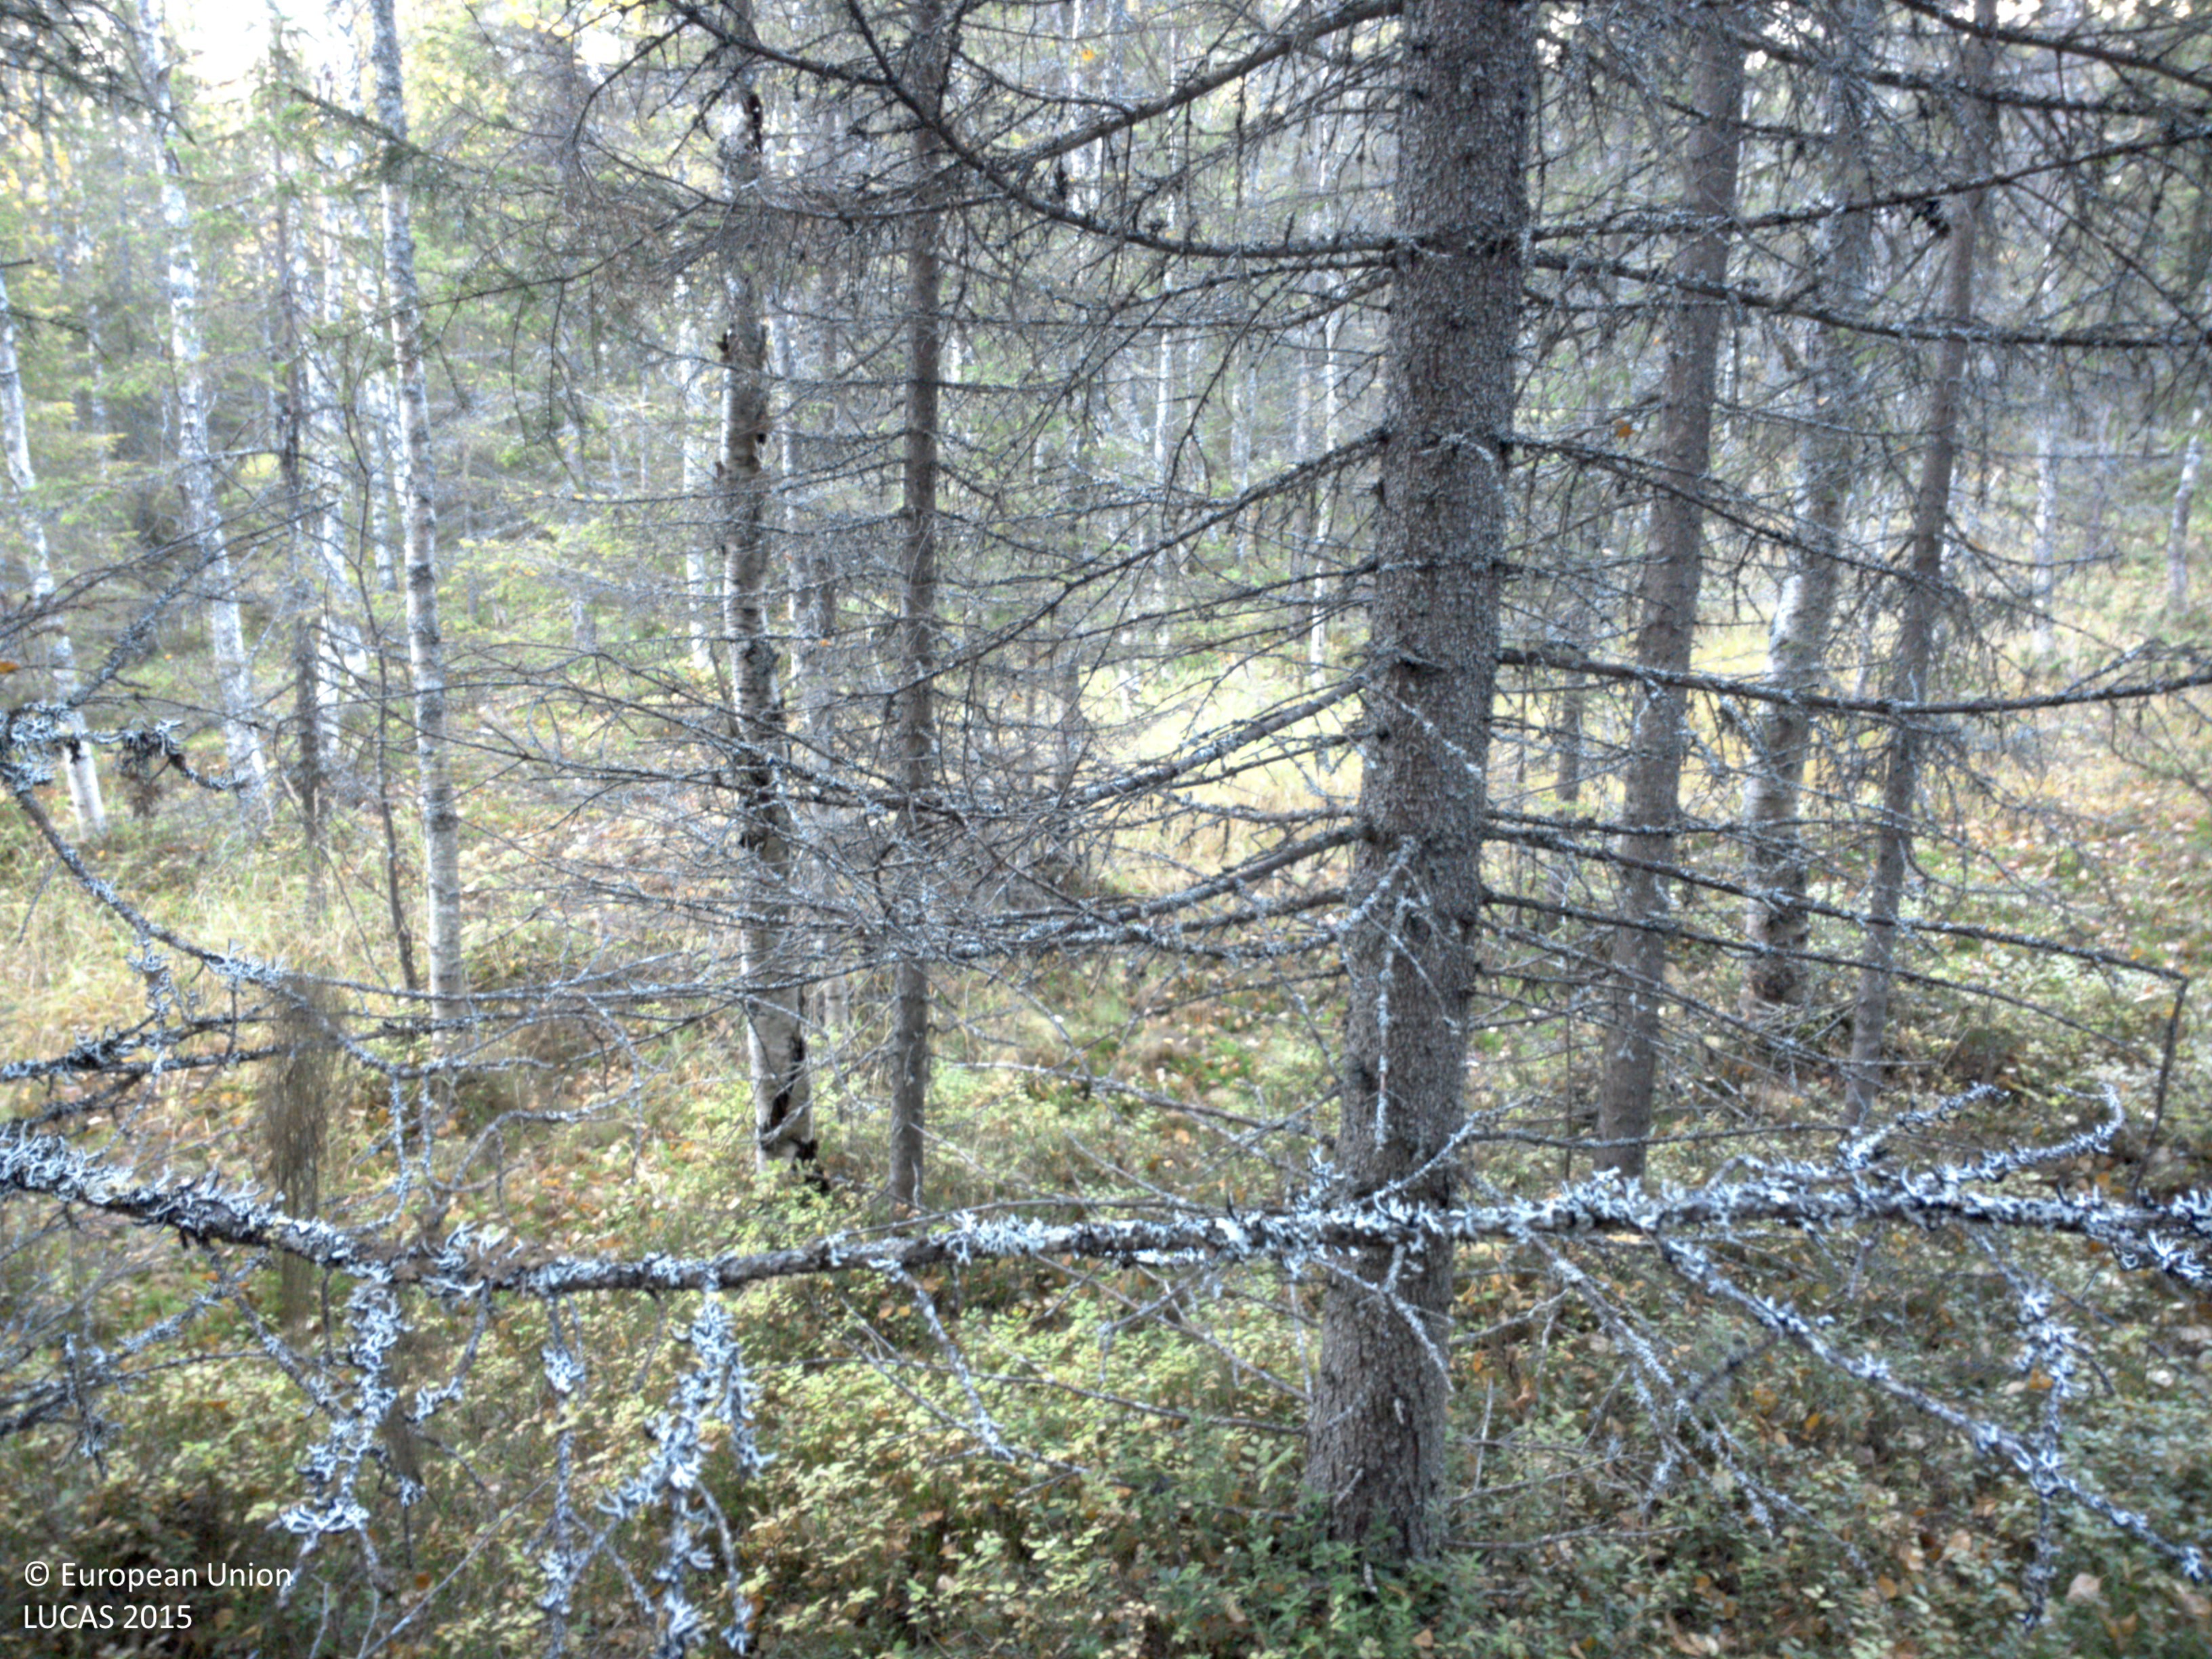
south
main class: Woodland
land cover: Spruce dominated mixed woodland
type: boreal forest
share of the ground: 50 - 75 %
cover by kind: coniferous forest trees 45 %, shrubs 30 %, broadleaved forest trees 15 %, herbaceous plants 10 %
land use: Forestry
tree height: > 5 m
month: October
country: SE
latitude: 64.6594
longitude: 17.8188
